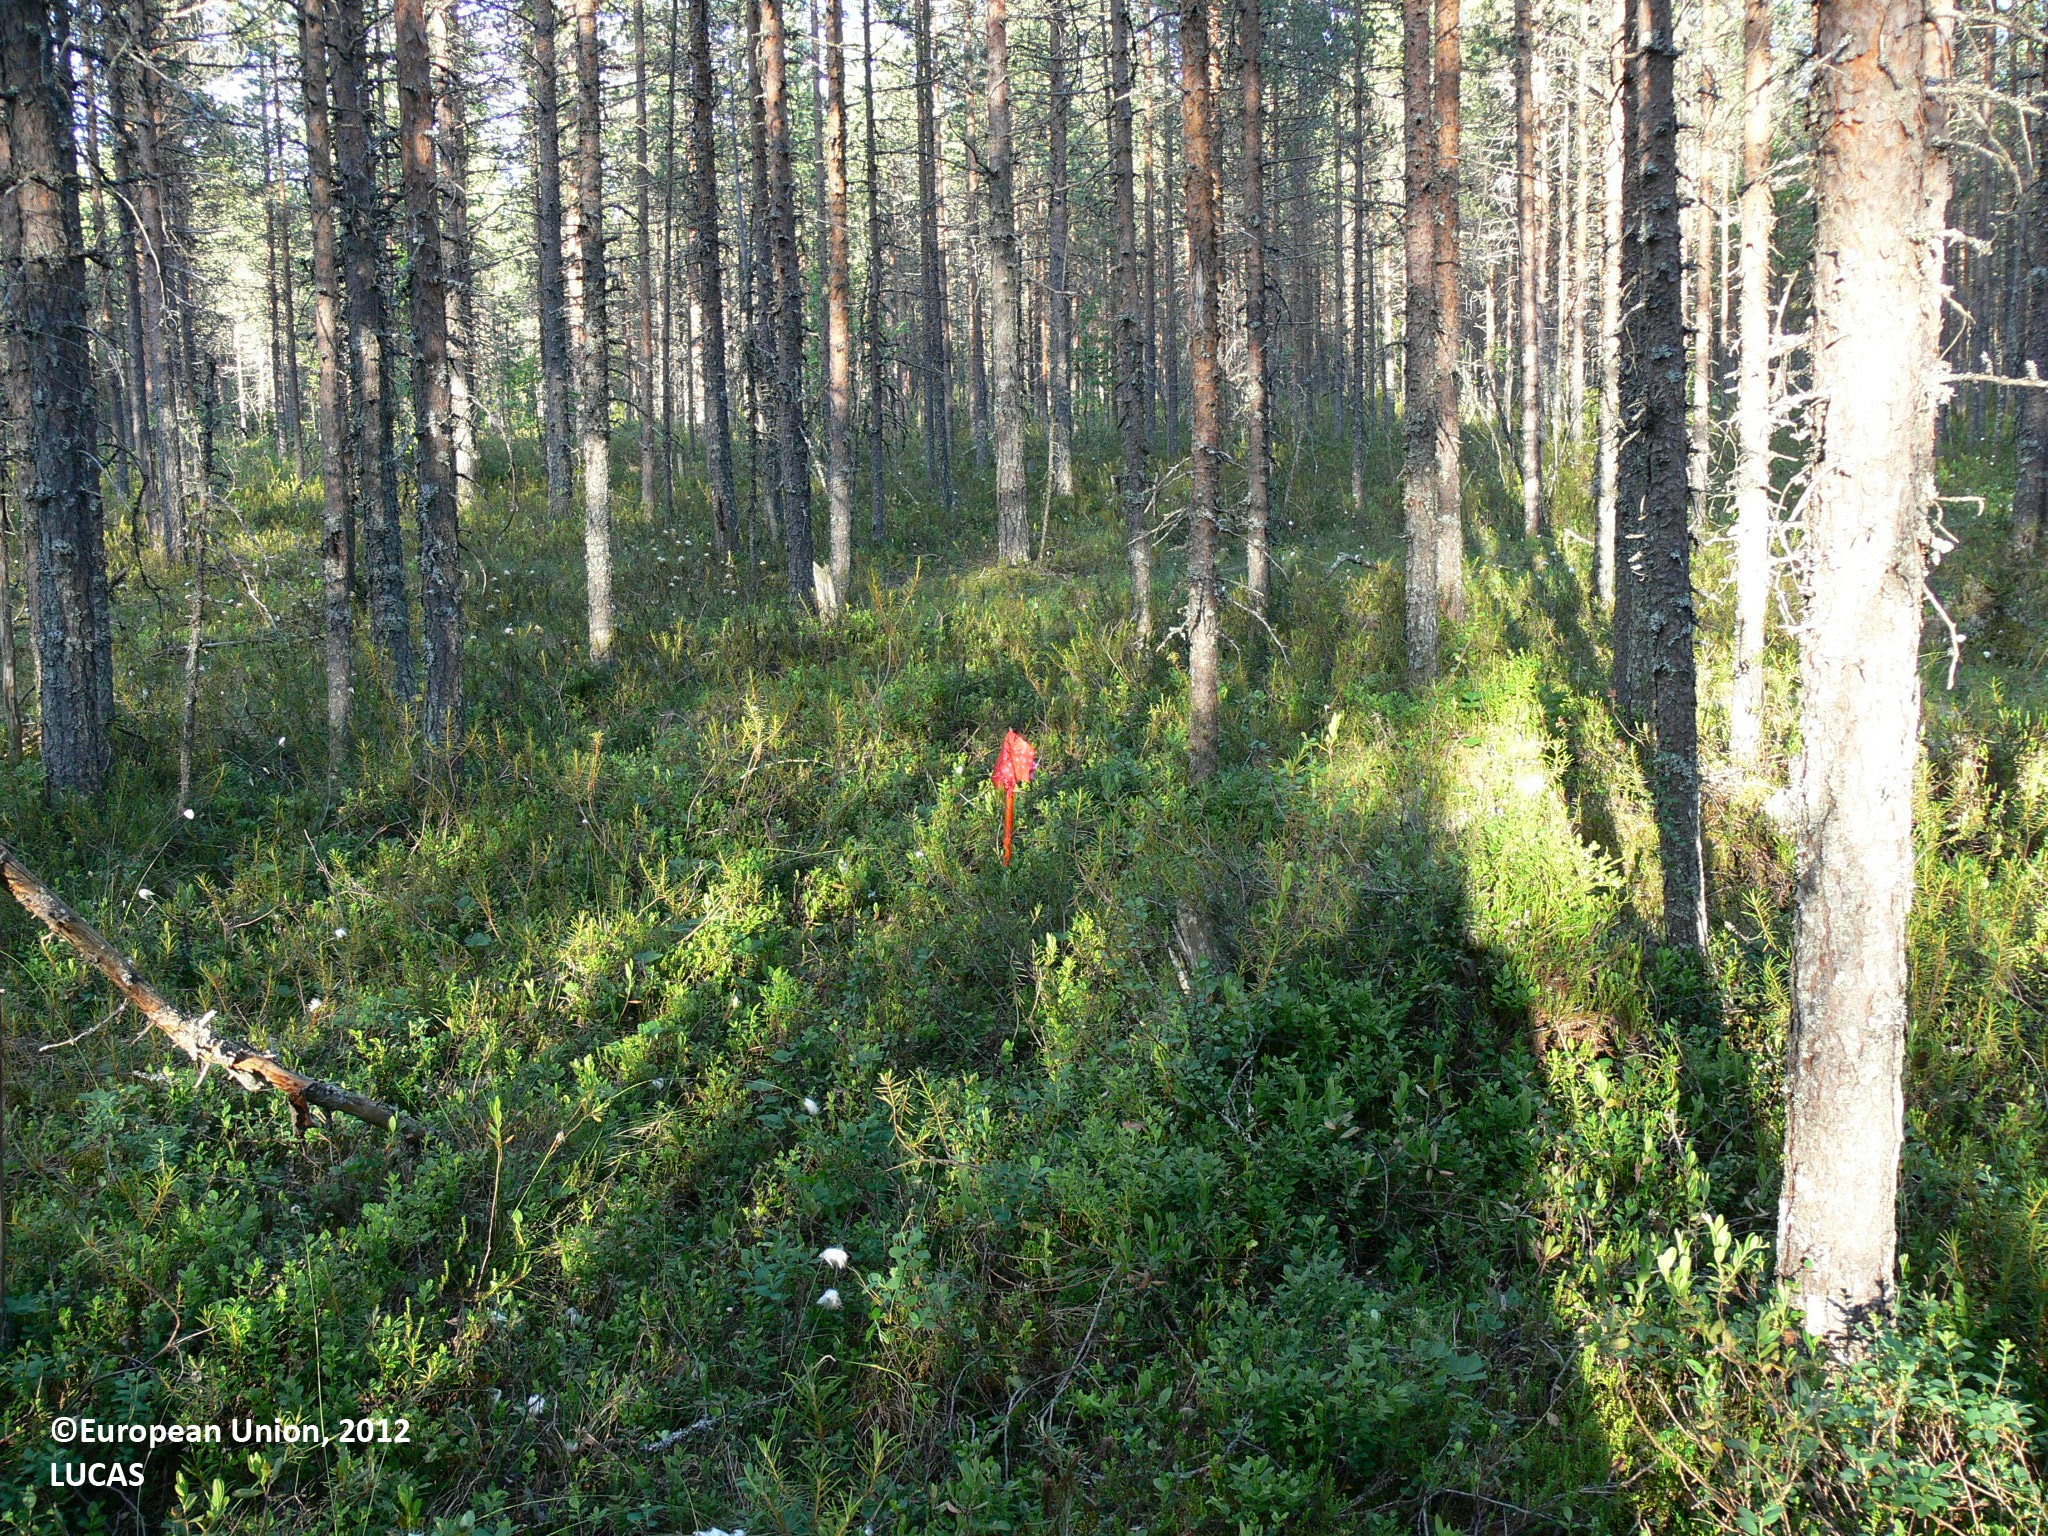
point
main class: Woodland
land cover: Pine dominated coniferous woodland
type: boreal forest
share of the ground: > 75 %
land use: Forestry
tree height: > 5 m
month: July
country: FI
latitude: 62.9037
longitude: 31.0238
